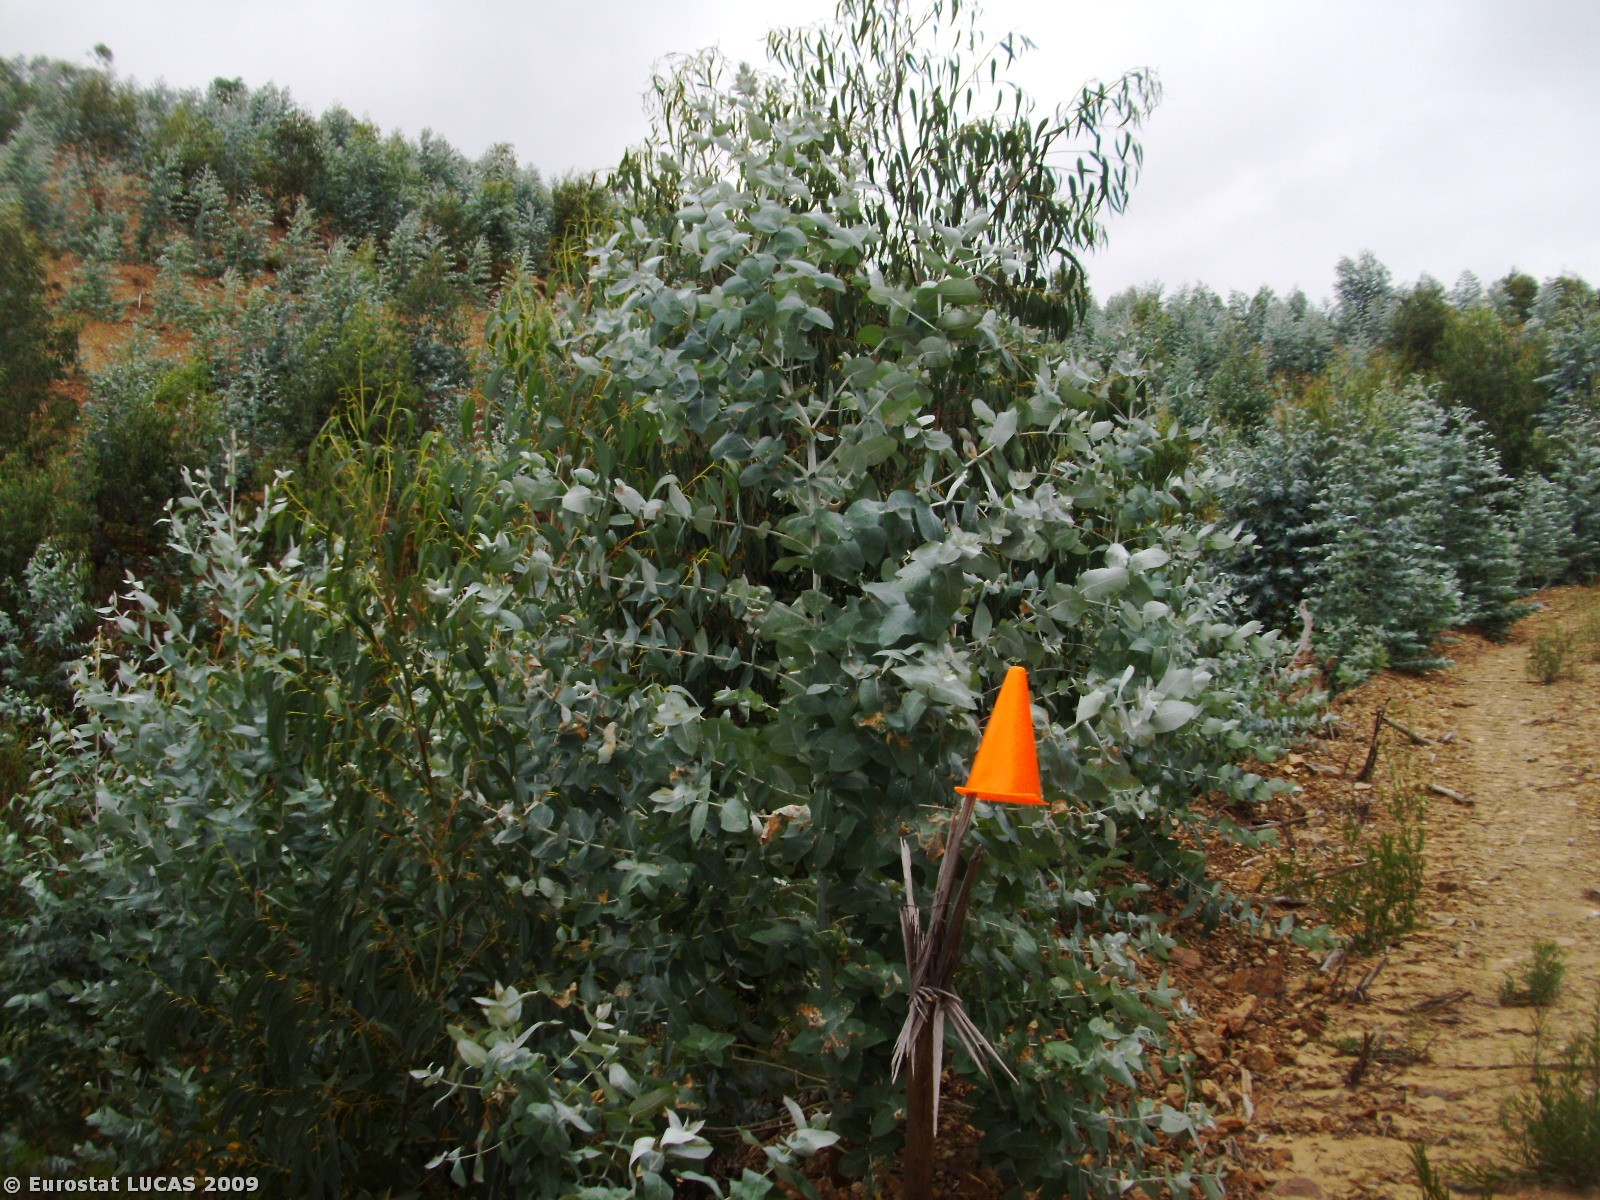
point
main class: Woodland
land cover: Broadleaved woodland
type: plantations and self-sown exotic forest
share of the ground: > 75 %
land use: Forestry
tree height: > 5 m
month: July
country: PT
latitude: 39.7956
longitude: -8.2548
